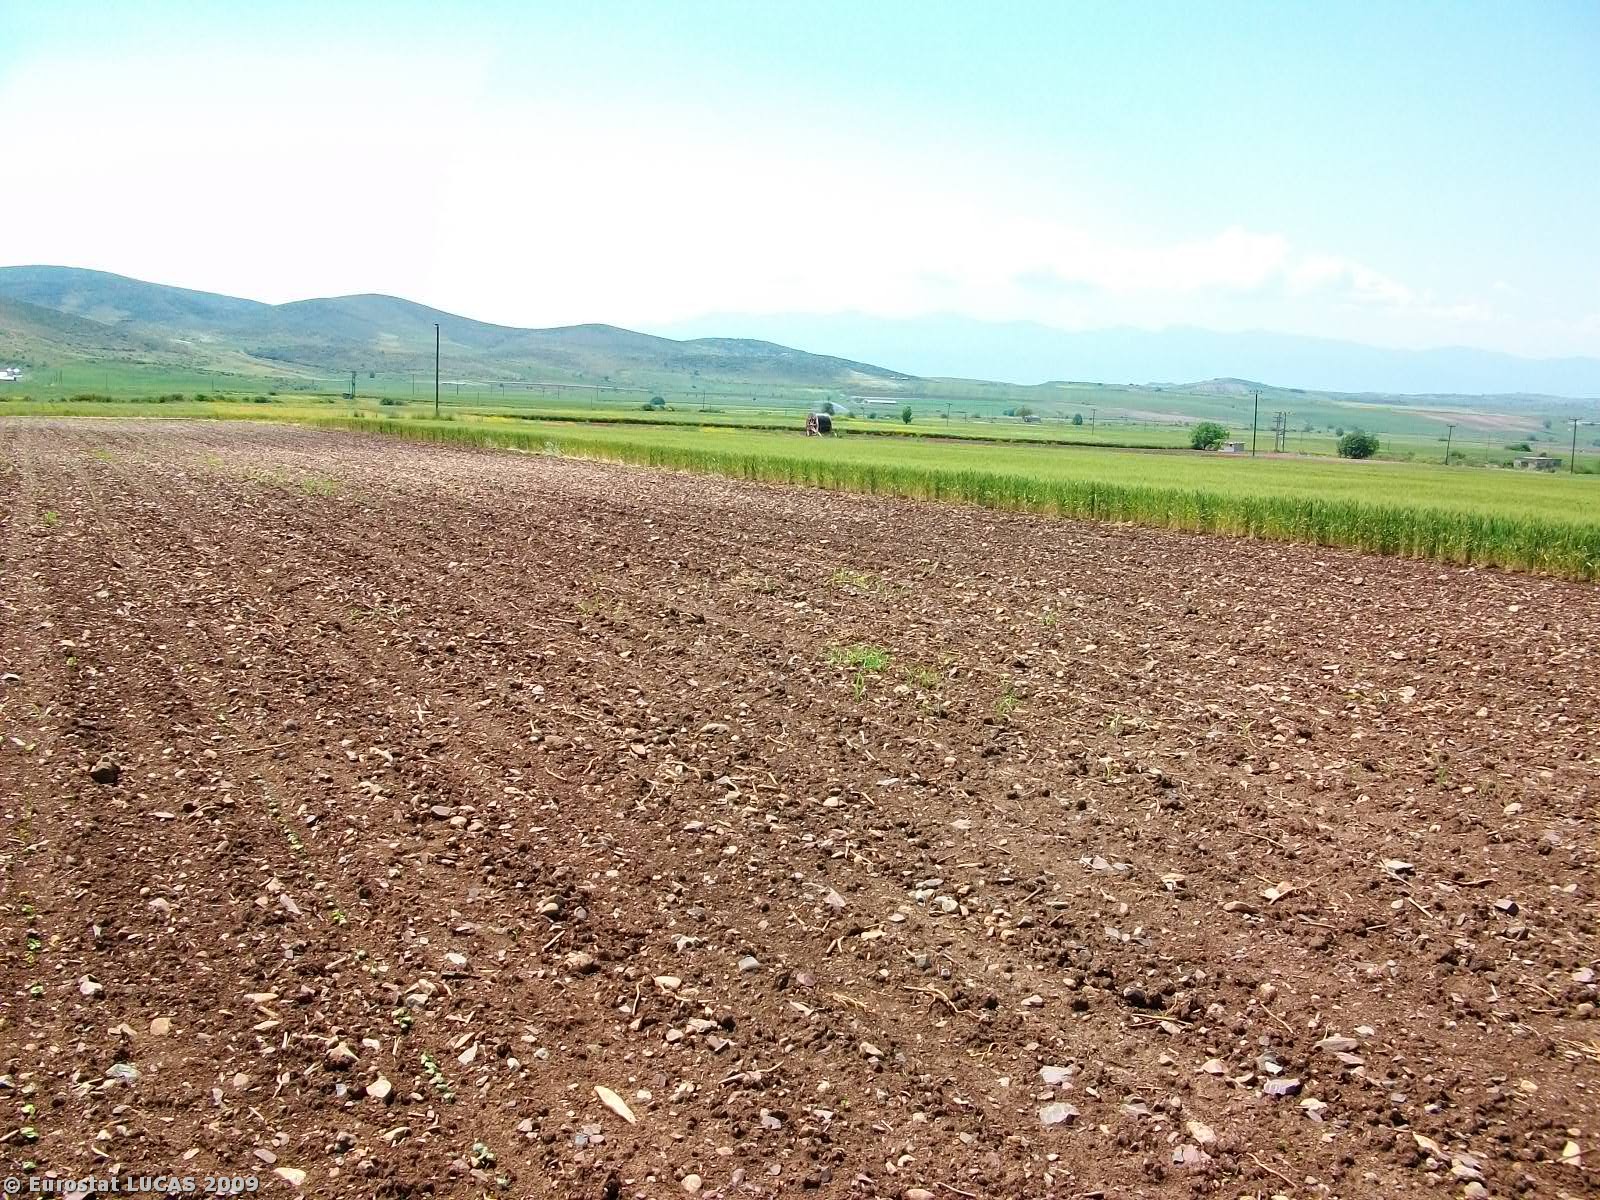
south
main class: Cropland
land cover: Cotton
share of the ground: < 10 %
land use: Agriculture (excluding fallow land and kitchen gardens)
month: May
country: GR
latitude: 39.3355
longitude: 22.7861
